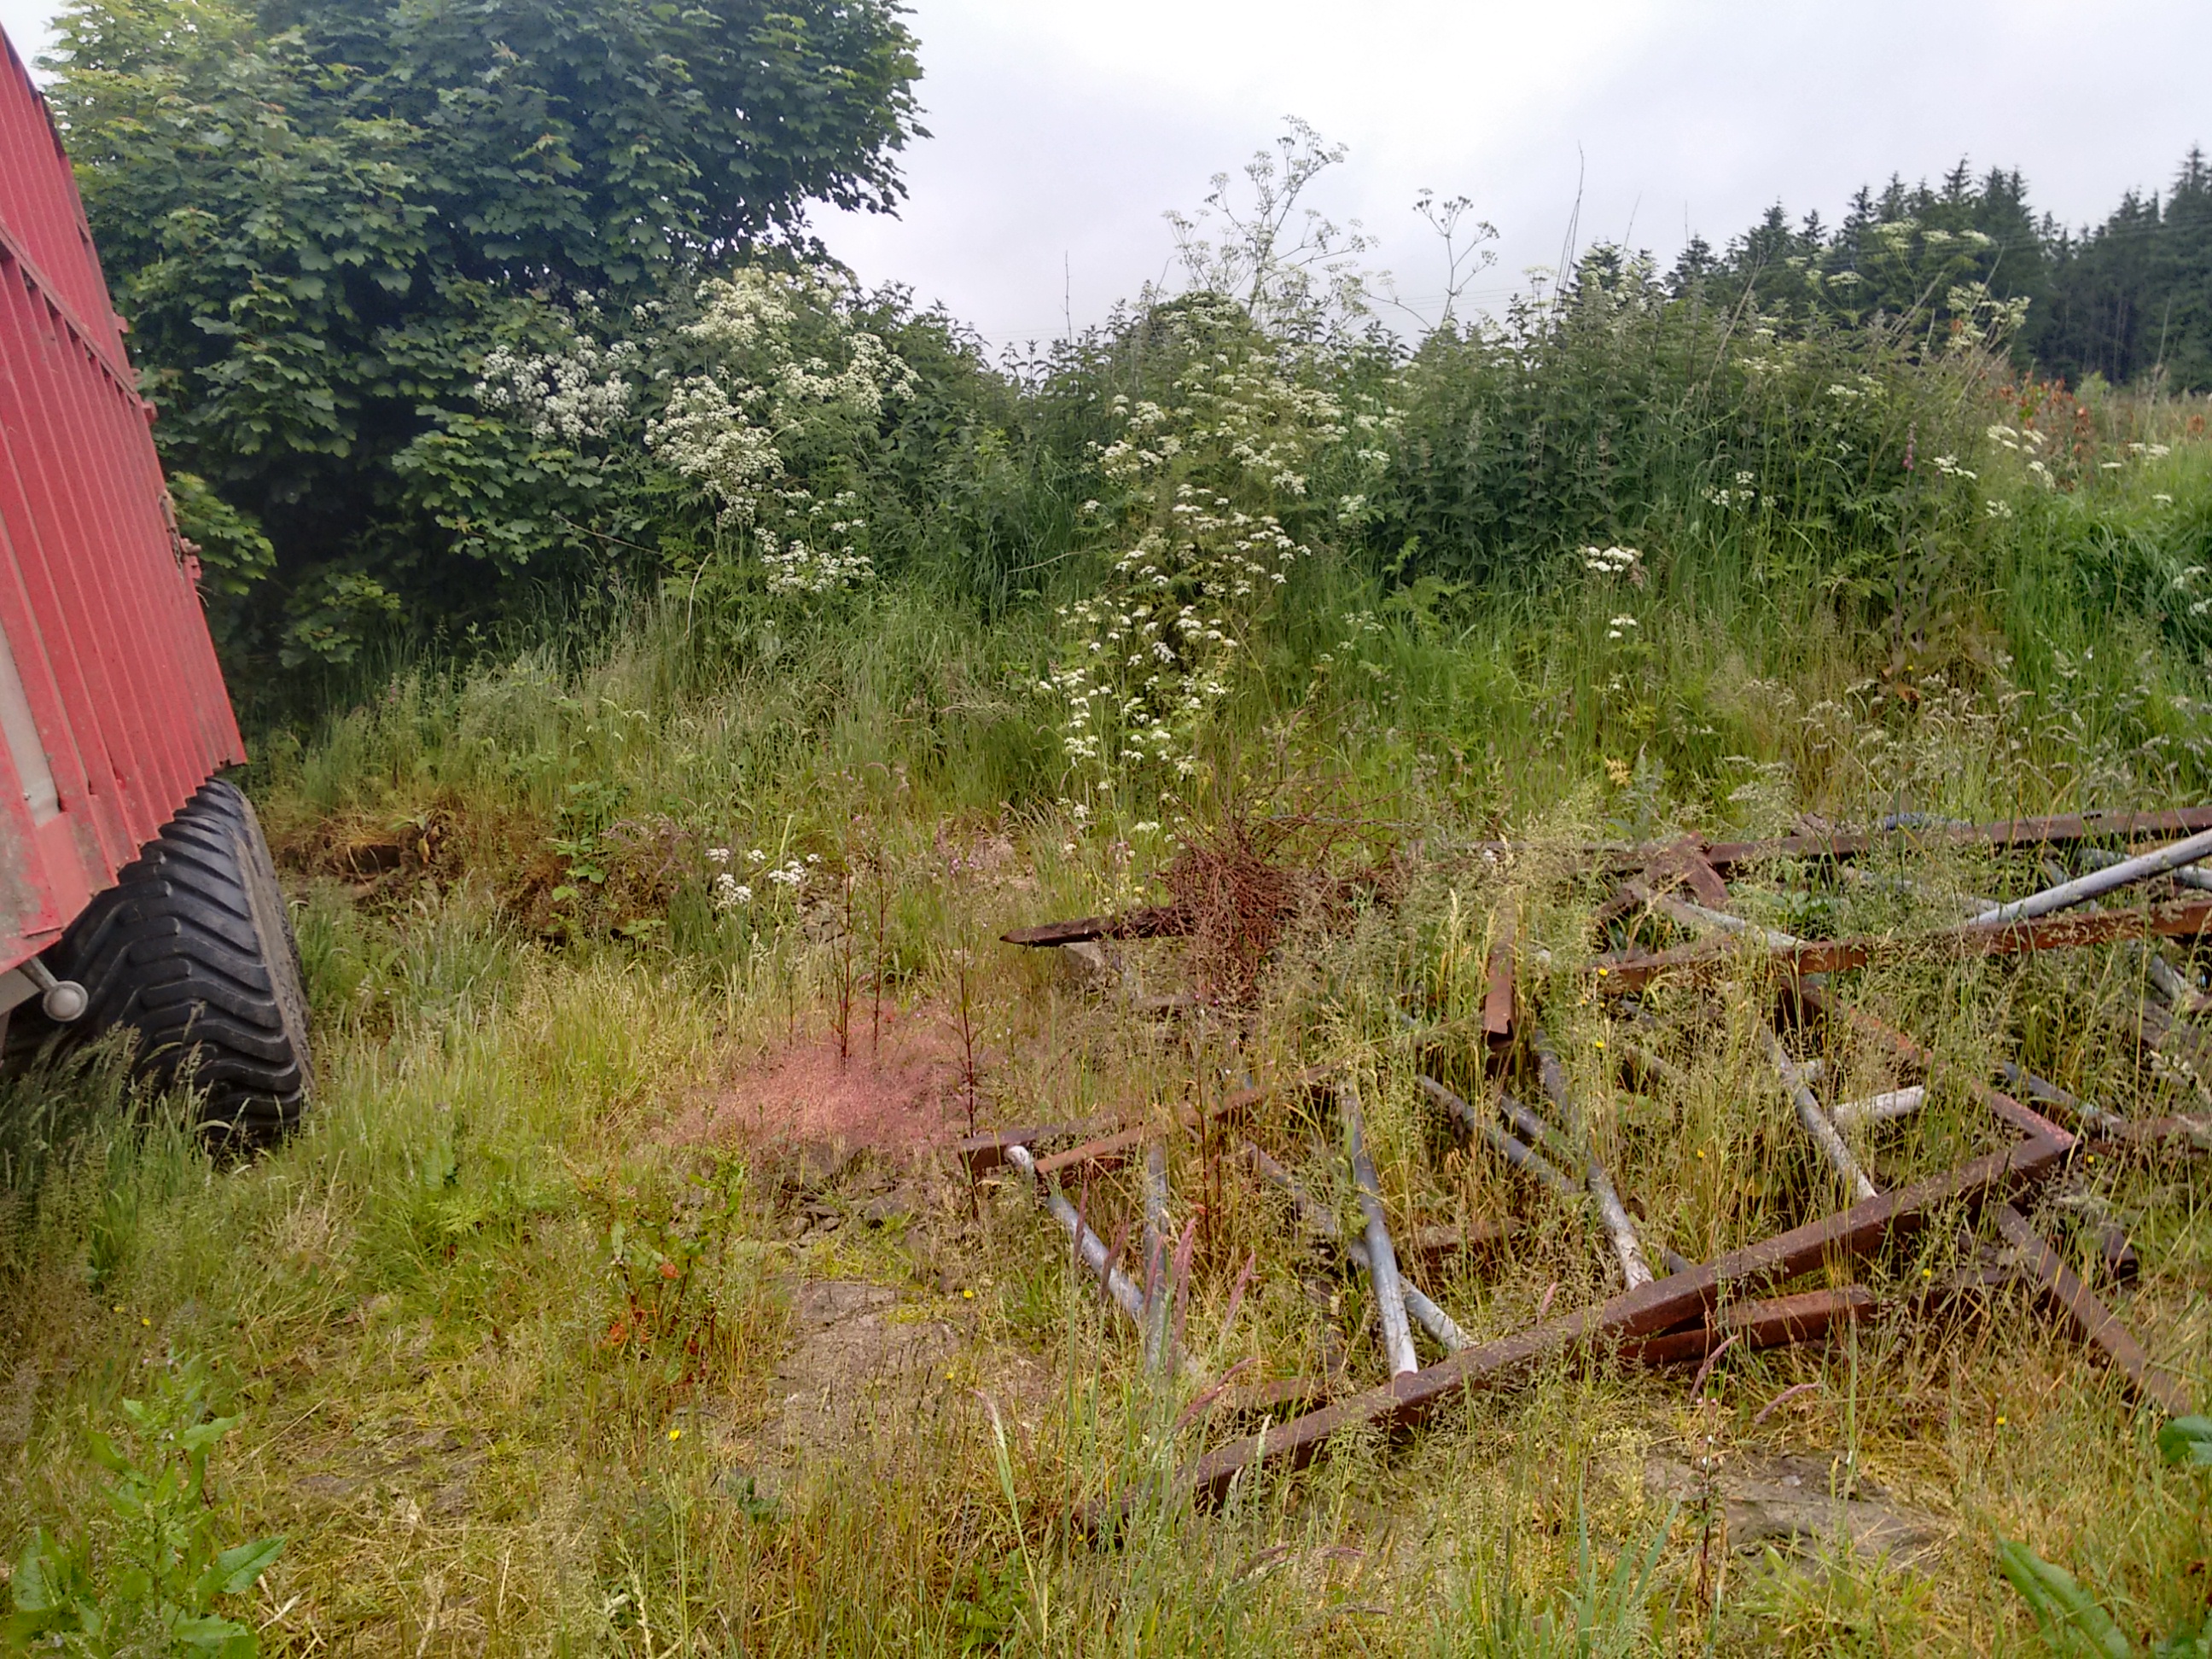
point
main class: Grassland
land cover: Grassland without tree/shrub cover
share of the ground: > 75 %
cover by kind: herbaceous plants 100 %
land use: Agriculture (excluding fallow land and kitchen gardens)
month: June
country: GB
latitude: 54.6783
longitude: -7.4781
